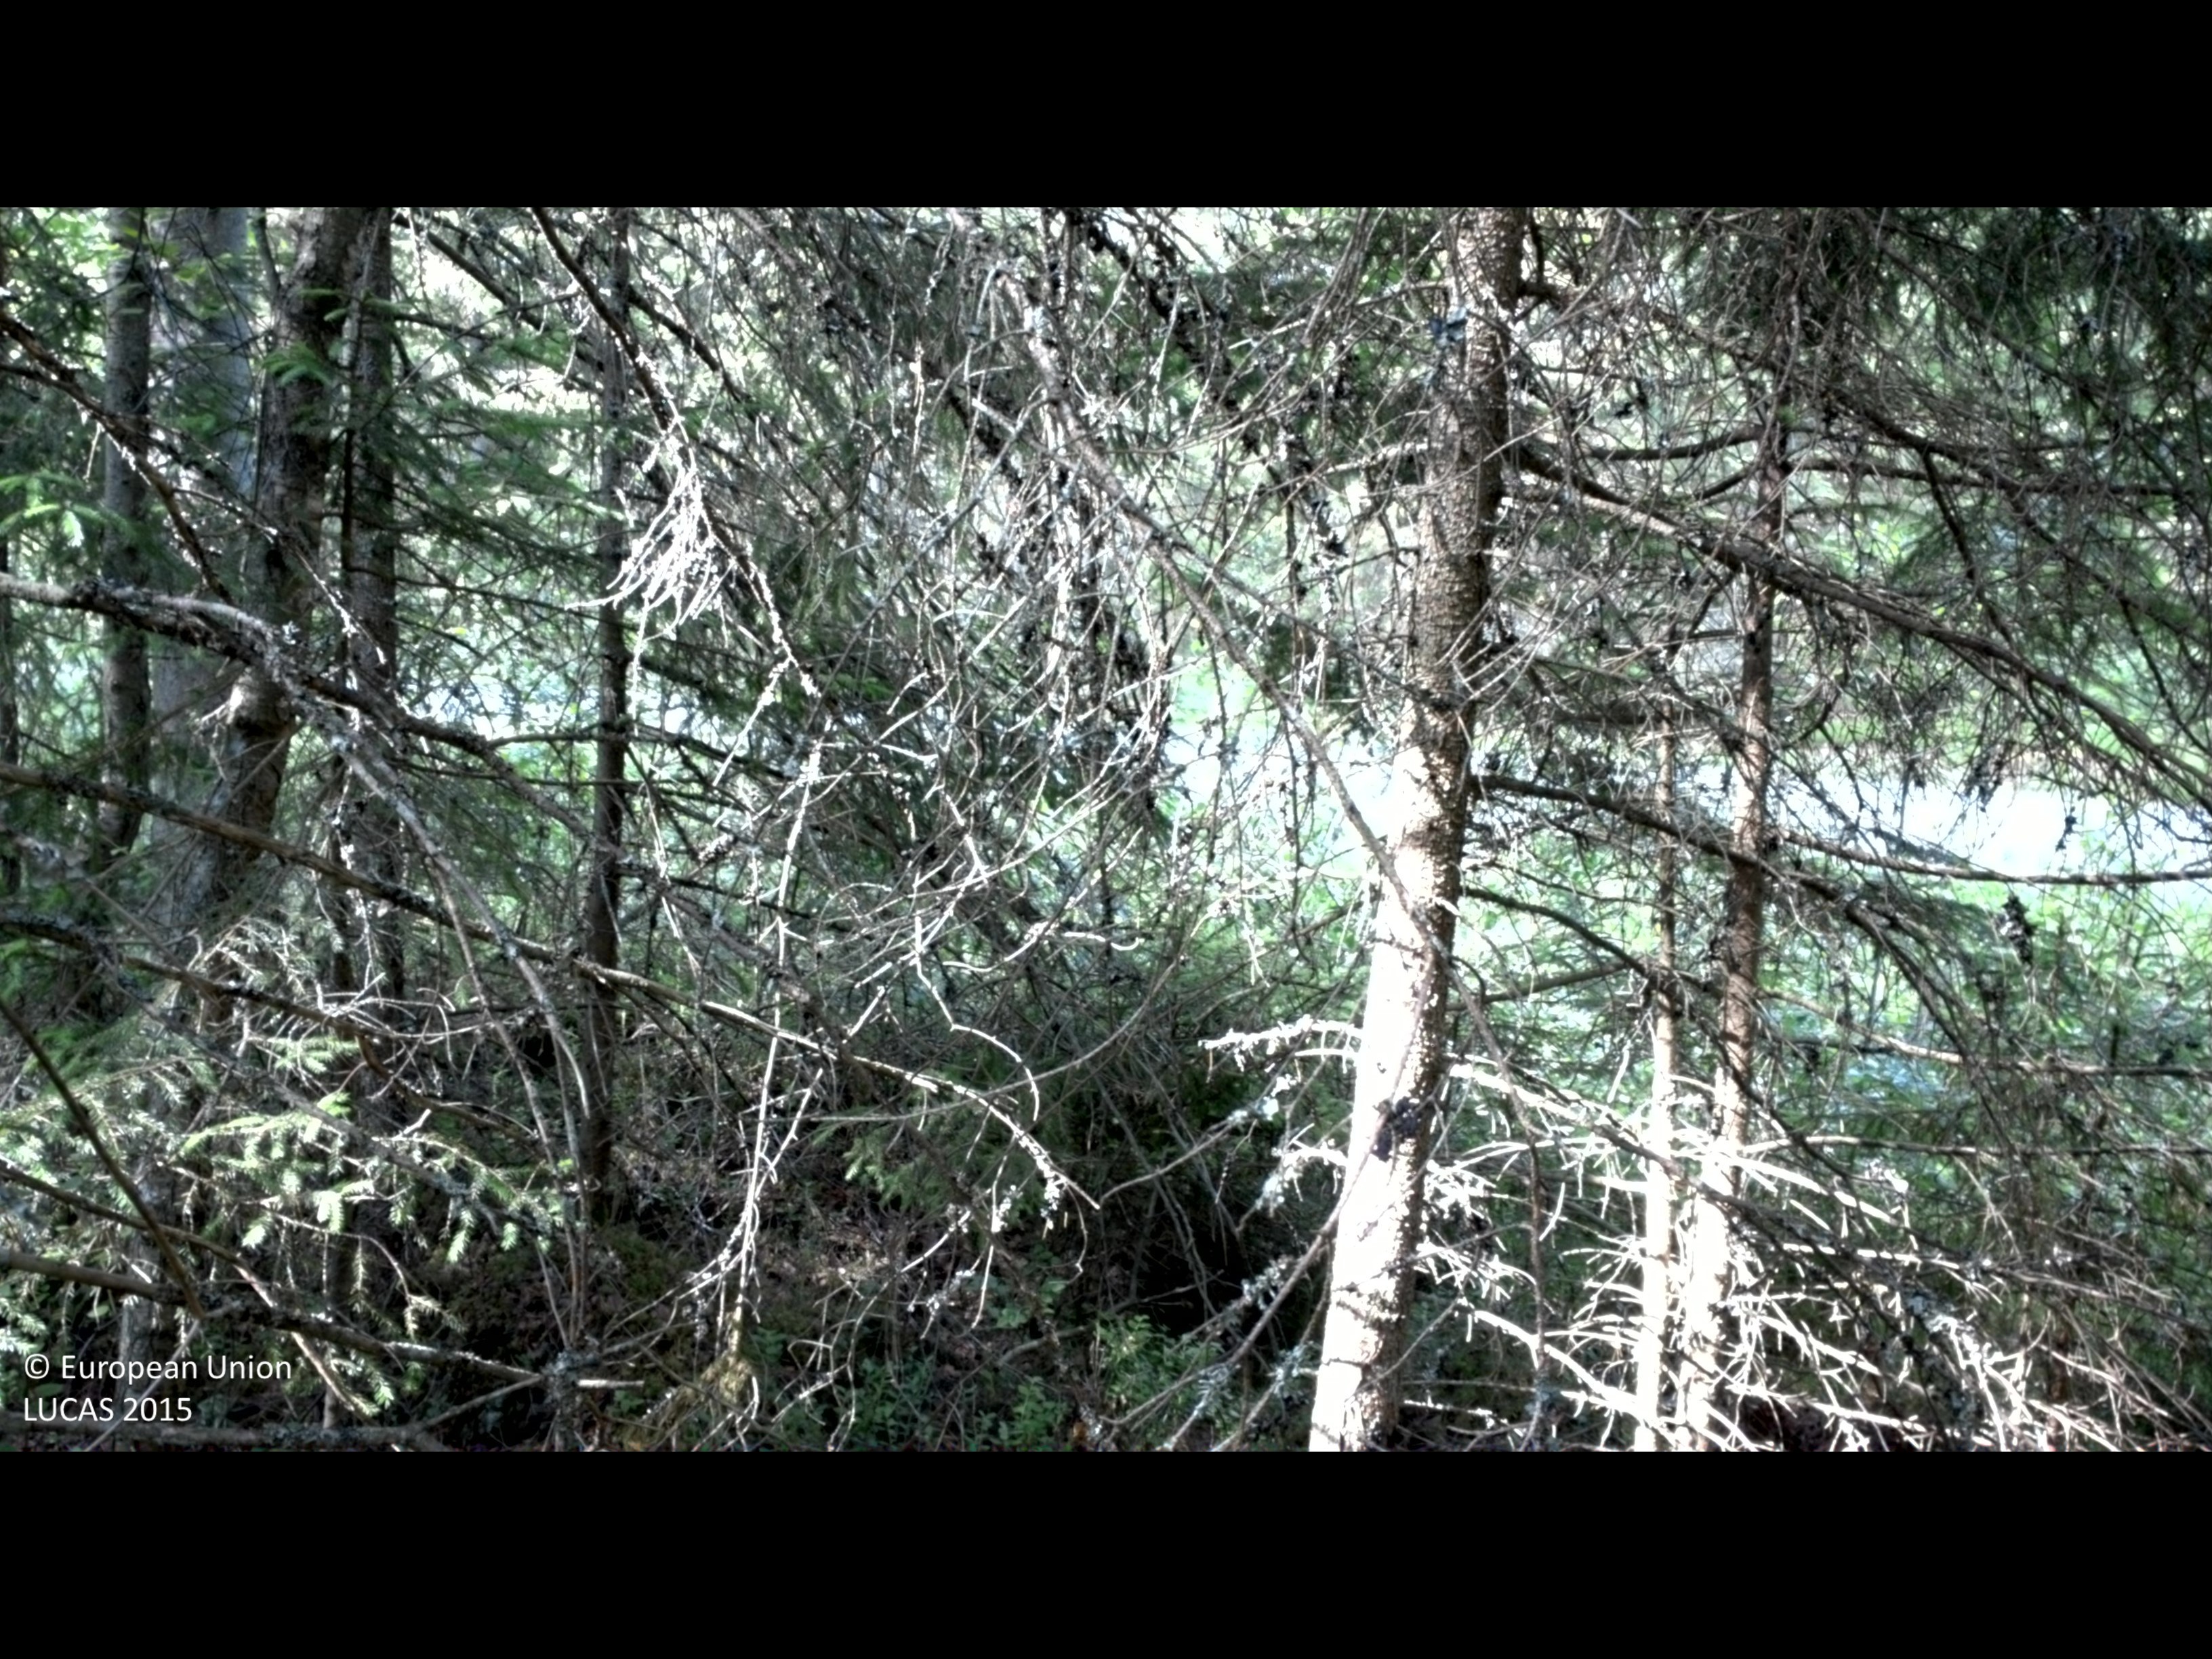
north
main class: Woodland
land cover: Spruce dominated coniferous woodland
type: boreal forest
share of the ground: 50 - 75 %
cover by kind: coniferous forest trees 55 %, shrubs 25 %, broadleaved forest trees 15 %, lichens and mosses 5 %
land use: Forestry
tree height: > 5 m
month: July
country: SE
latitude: 56.4580
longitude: 14.2976
